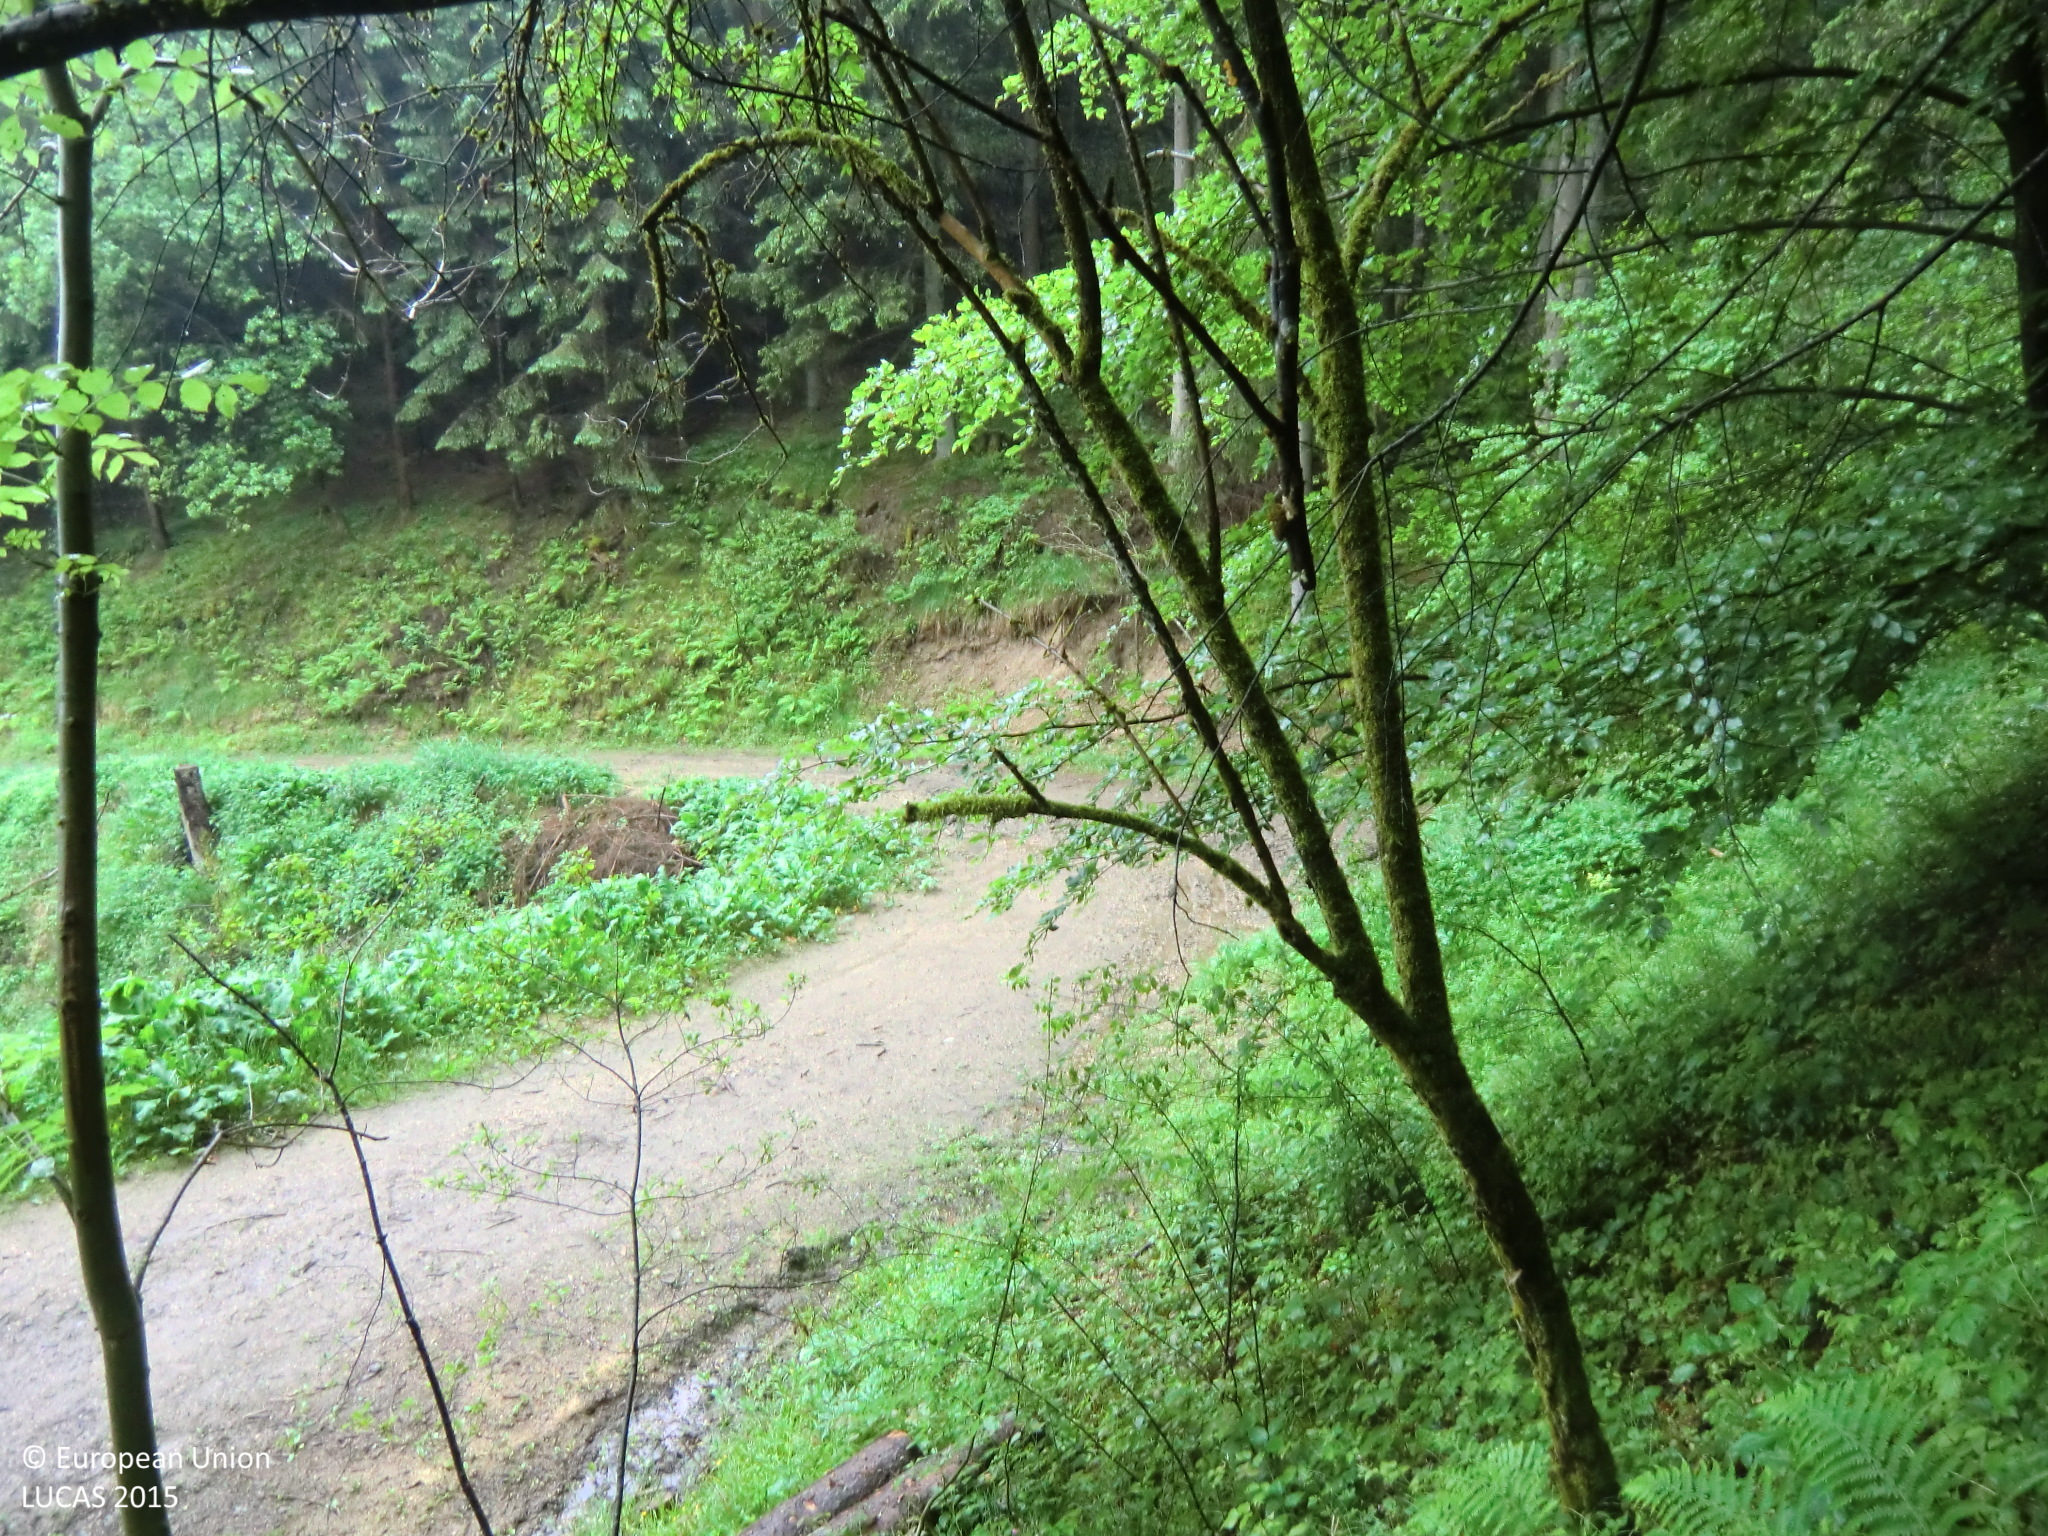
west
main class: Woodland
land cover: Spruce dominated mixed woodland
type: hemiboreal forest and nemoral coniferous forest and mixed broadleaved-coniferous forest
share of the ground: > 75 %
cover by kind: coniferous forest trees 40 %, broadleaved forest trees 40 %, herbaceous plants 20 %
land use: Forestry
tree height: > 5 m
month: May
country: AT
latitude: 48.3629
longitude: 14.5762
